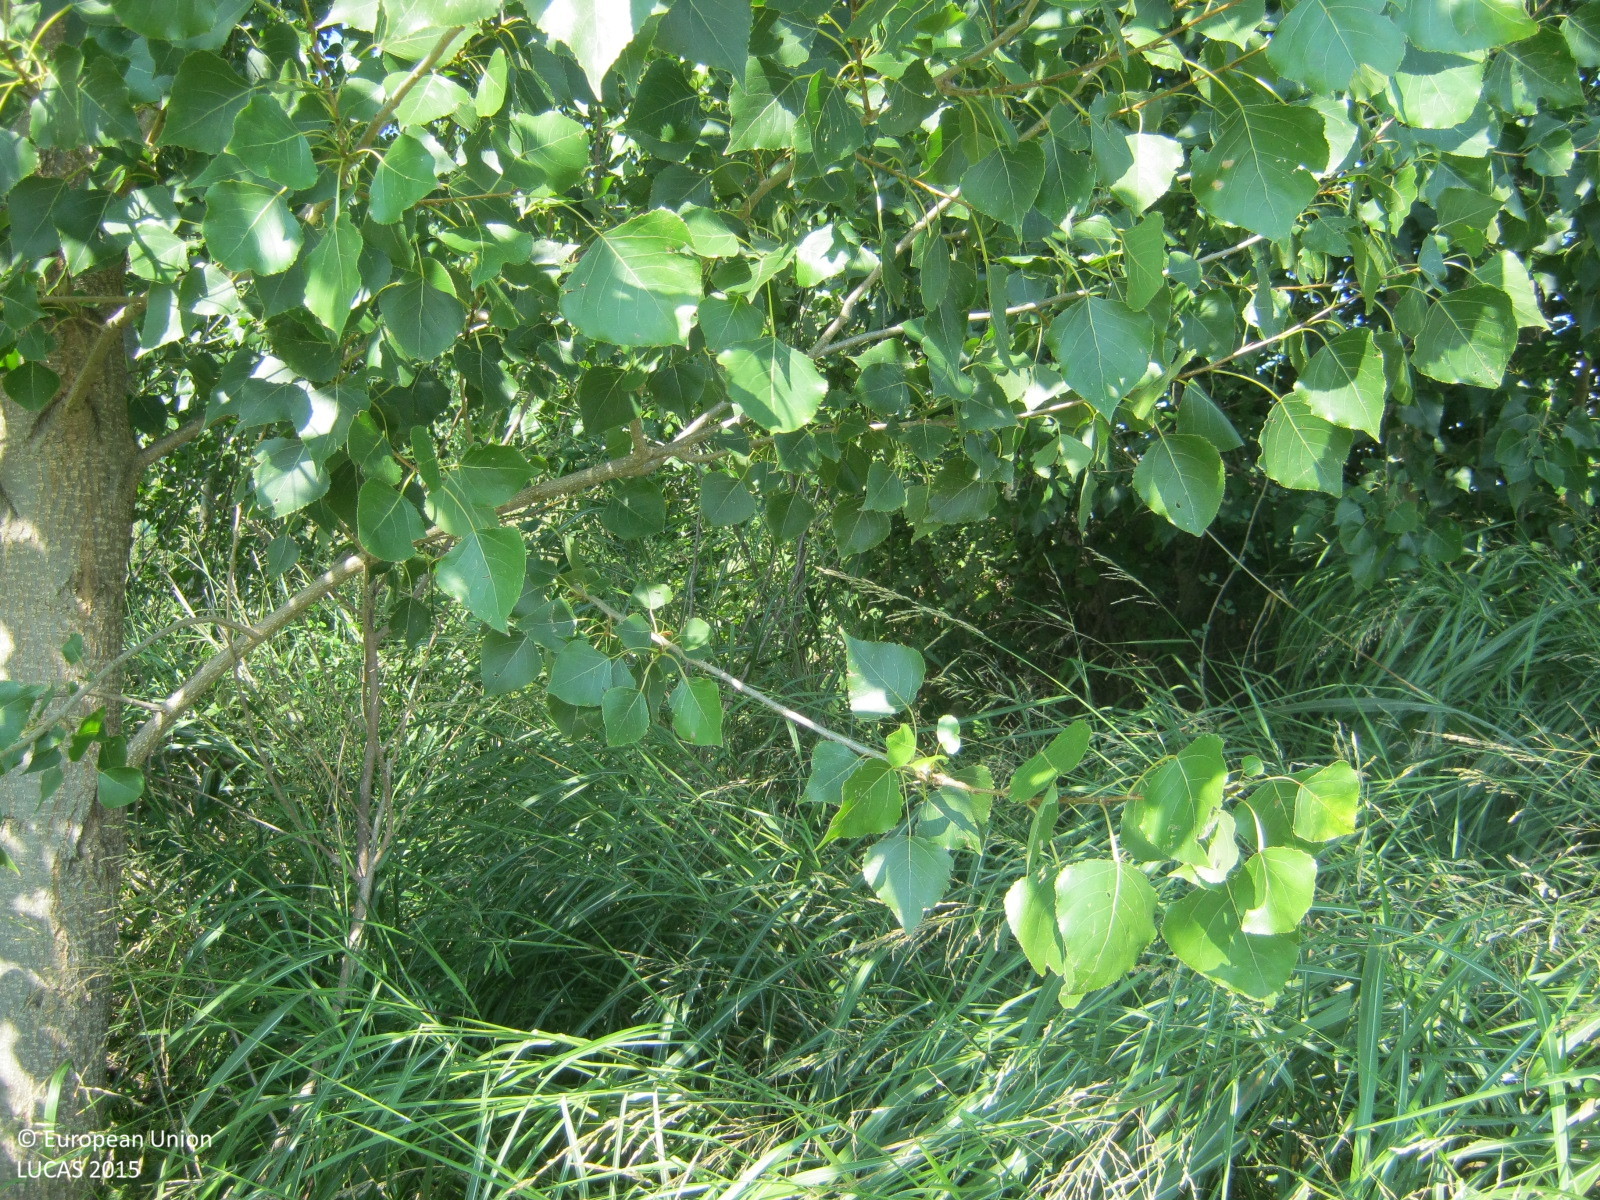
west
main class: Grassland
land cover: Spontaneously vegetated surfaces
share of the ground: > 75 %
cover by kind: herbaceous plants 100 %
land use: Semi-natural and natural areas not in use
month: September
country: GR
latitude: 41.1923
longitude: 23.2642
